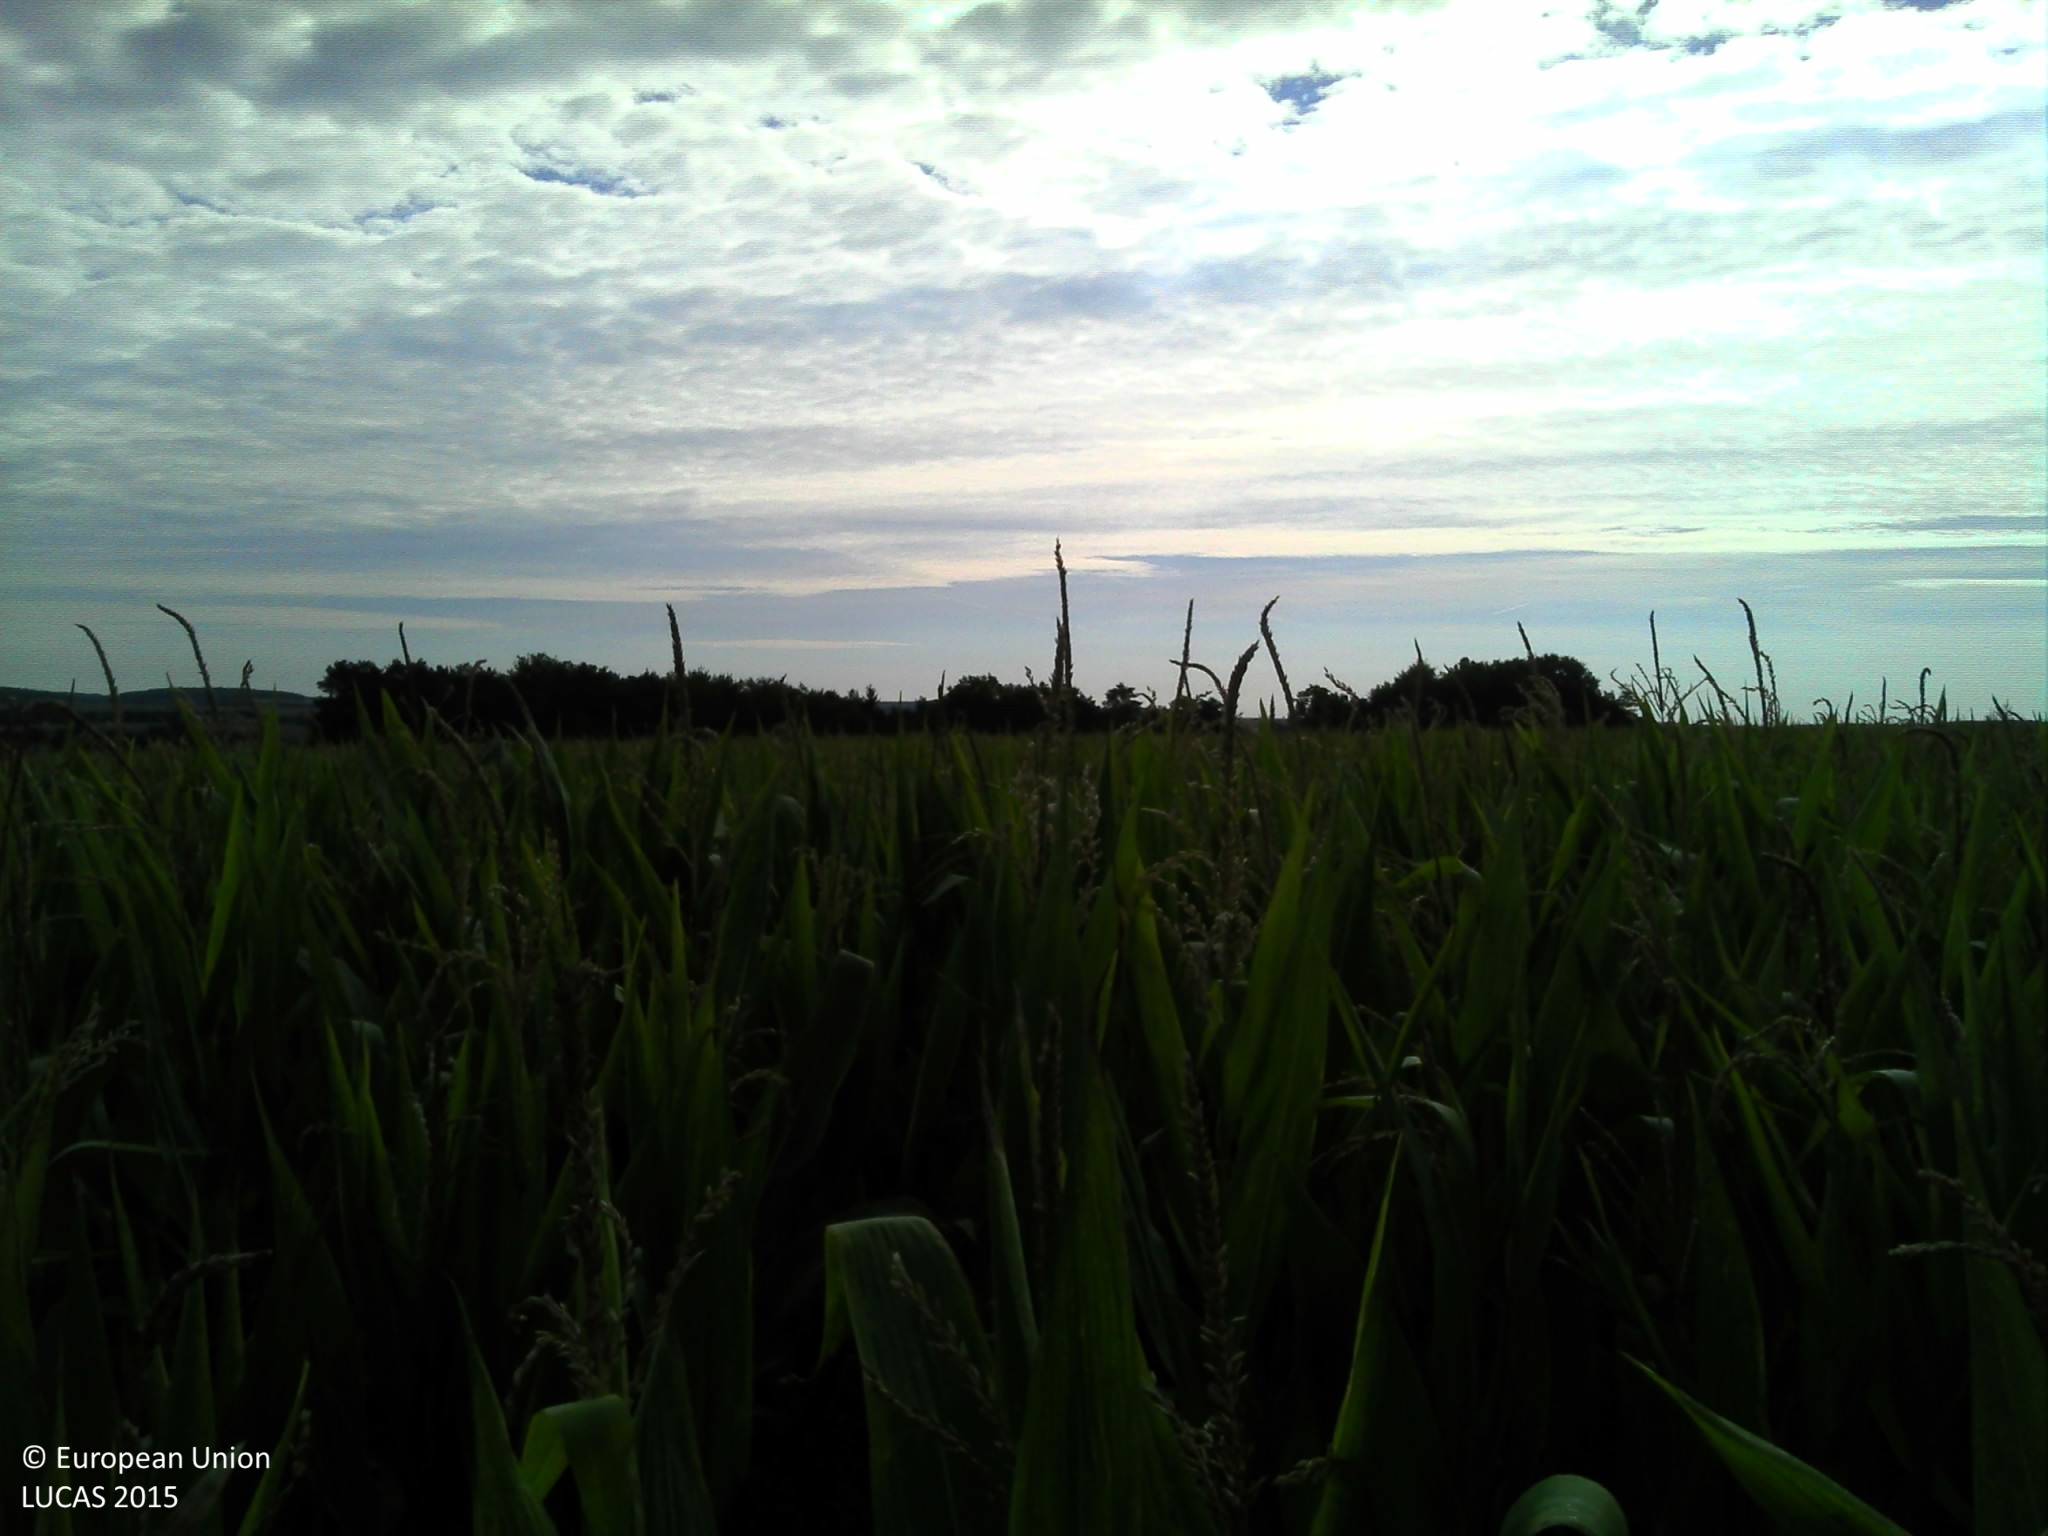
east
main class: Cropland
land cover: Maize
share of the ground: > 75 %
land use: Agriculture (excluding fallow land and kitchen gardens)
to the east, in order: Maize; Grass margins; Ditches and canals; Grass margins; Paved roads, cycling and walking lanes; Grassland without tree/shrub cover; Pine dominated mixed woodland
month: August
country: FR
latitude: 47.6702
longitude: 4.8453
